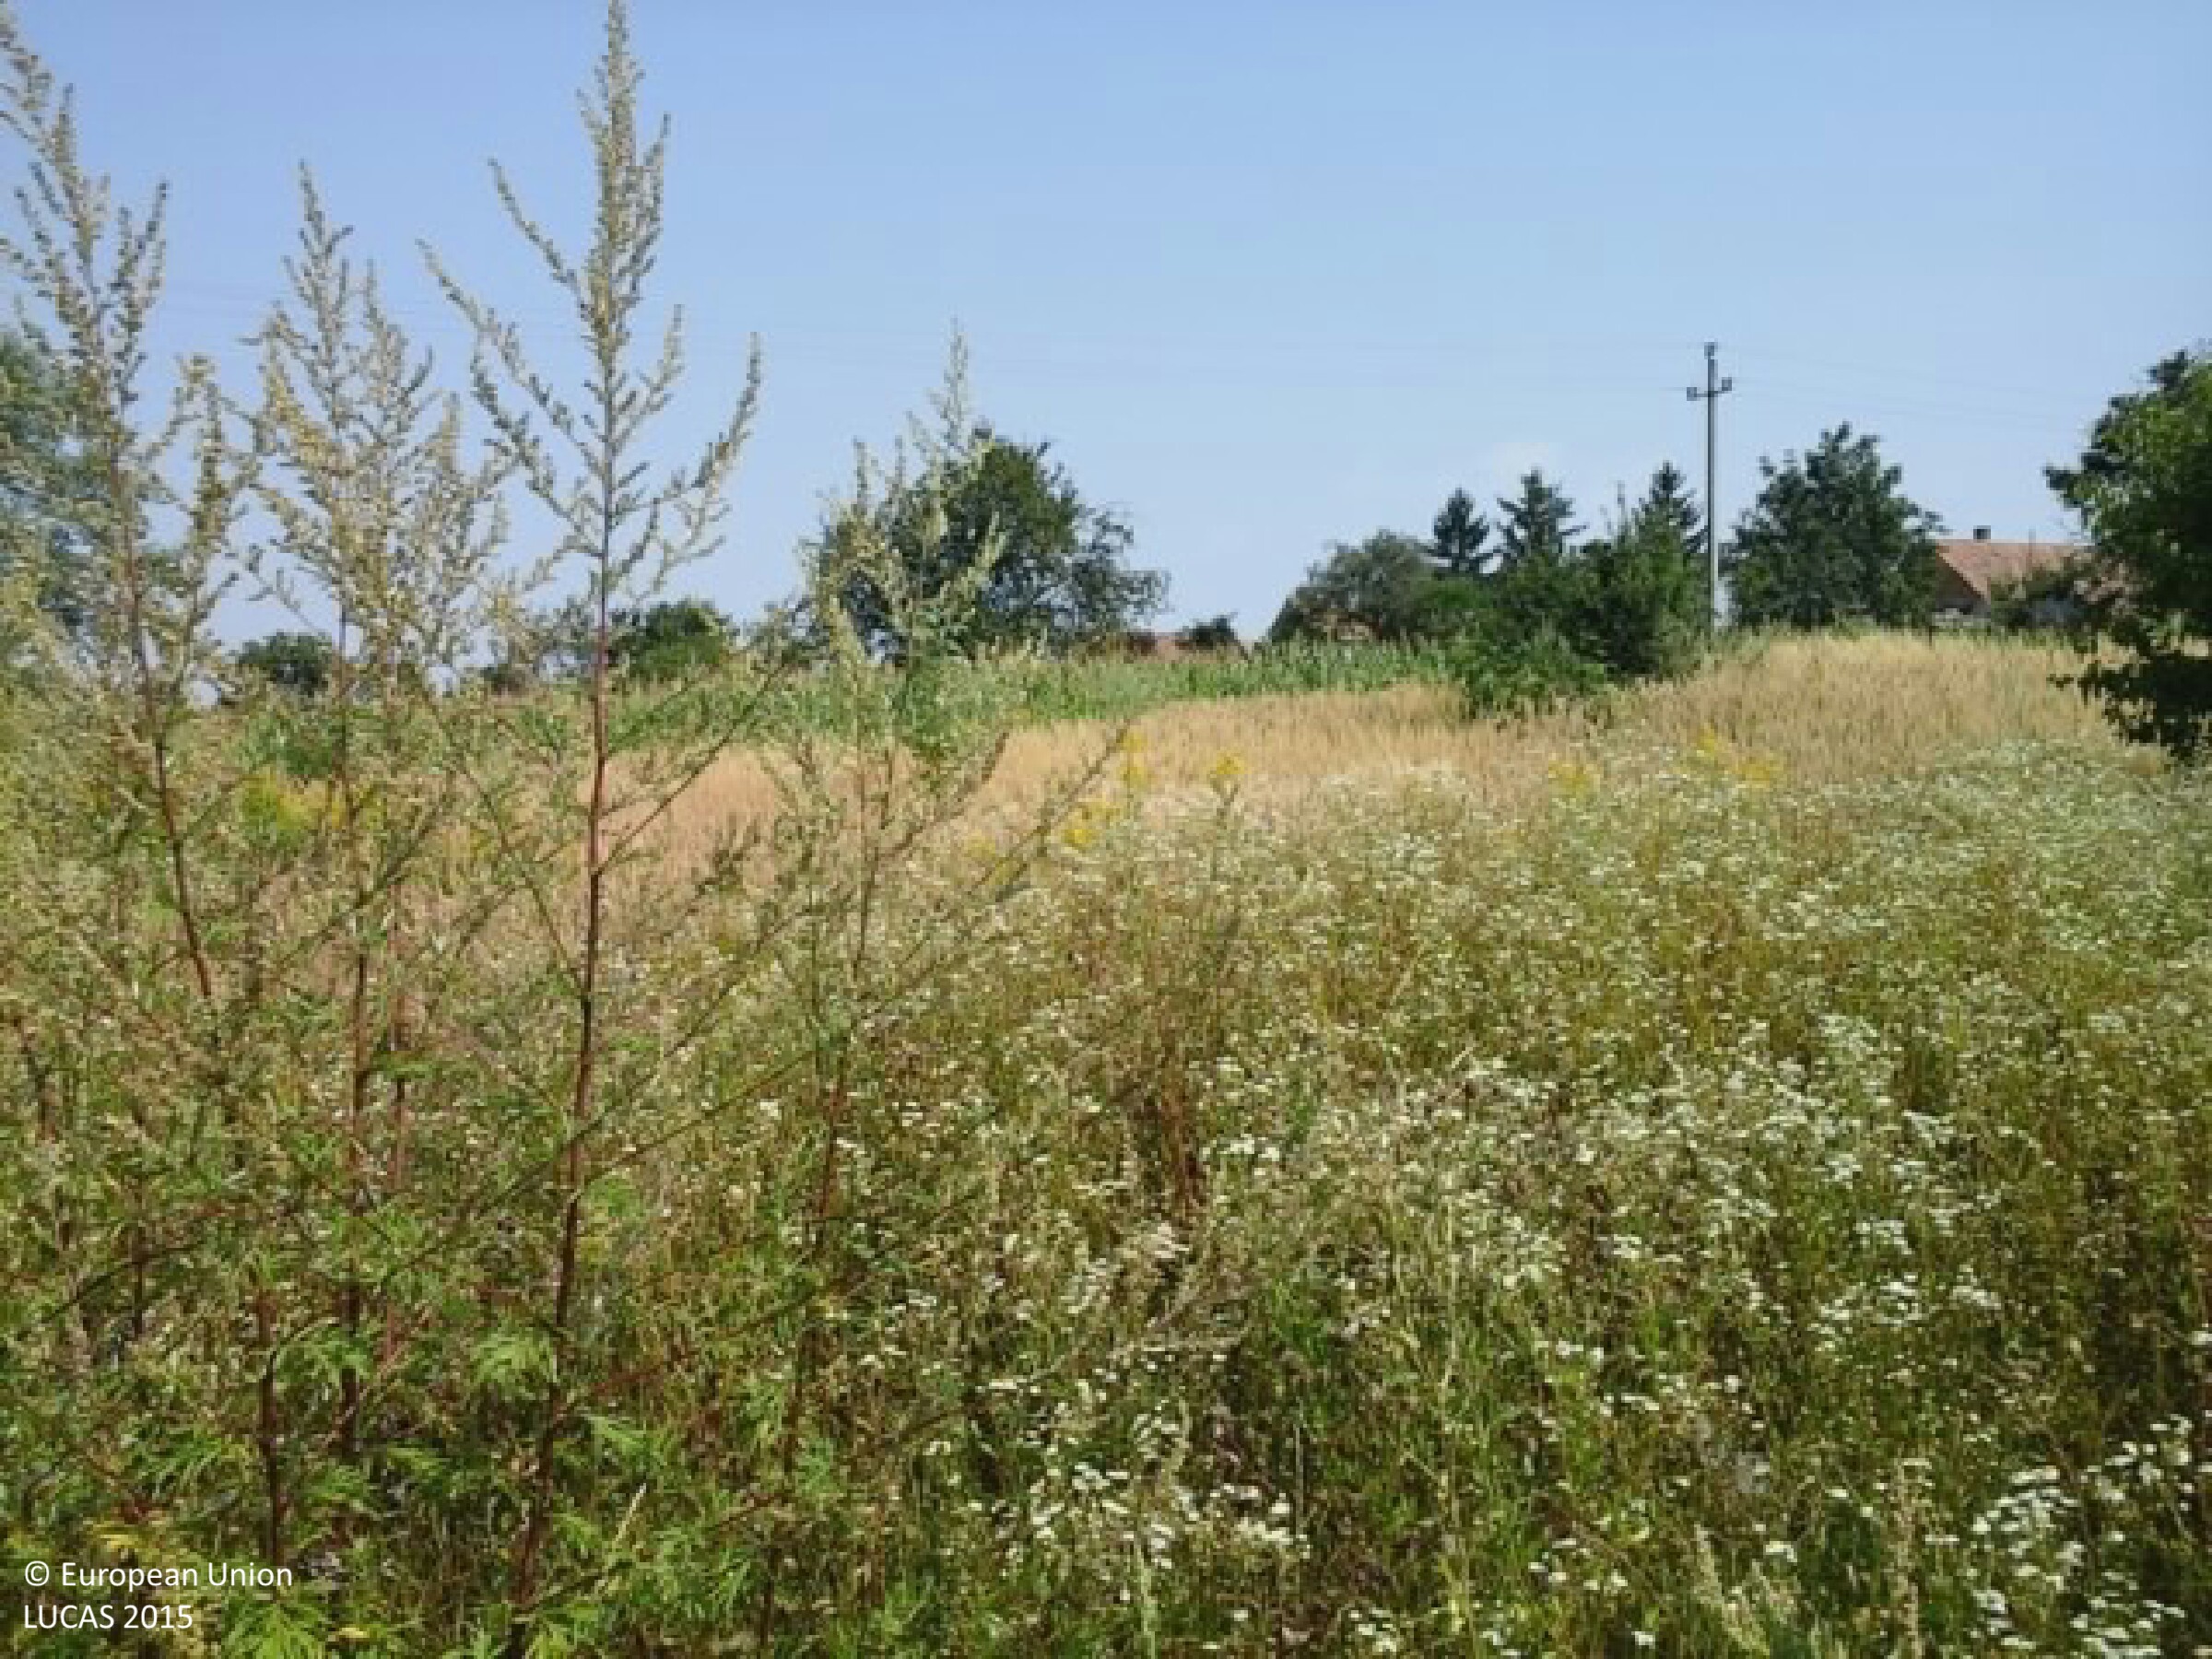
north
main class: Grassland
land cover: Spontaneously vegetated surfaces
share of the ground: > 75 %
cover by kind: herbaceous plants 100 %
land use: Residential
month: August
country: HU
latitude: 46.5889
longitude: 17.8247
